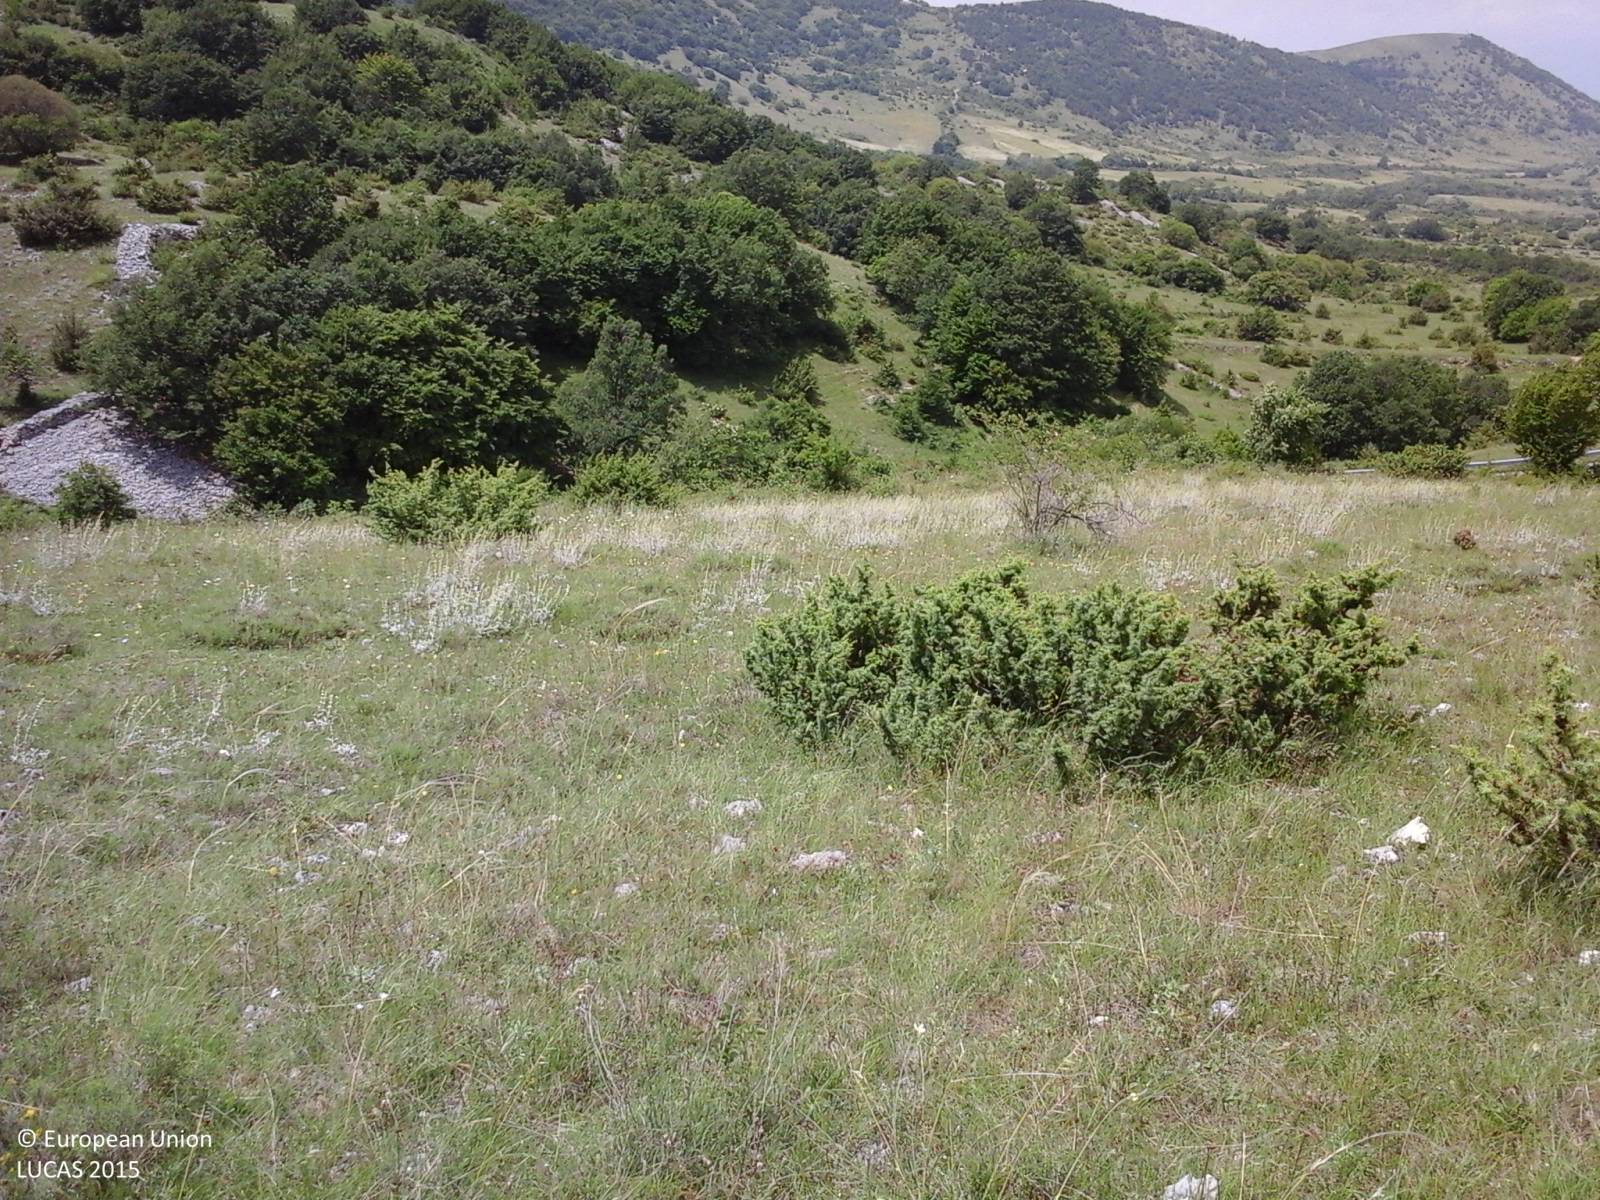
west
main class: Shrubland
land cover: Shrubland without tree cover
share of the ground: > 75 %
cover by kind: herbaceous plants 60 %, shrubs 40 %
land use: Agriculture (excluding fallow land and kitchen gardens)
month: June
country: IT
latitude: 41.9960
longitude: 14.0066
